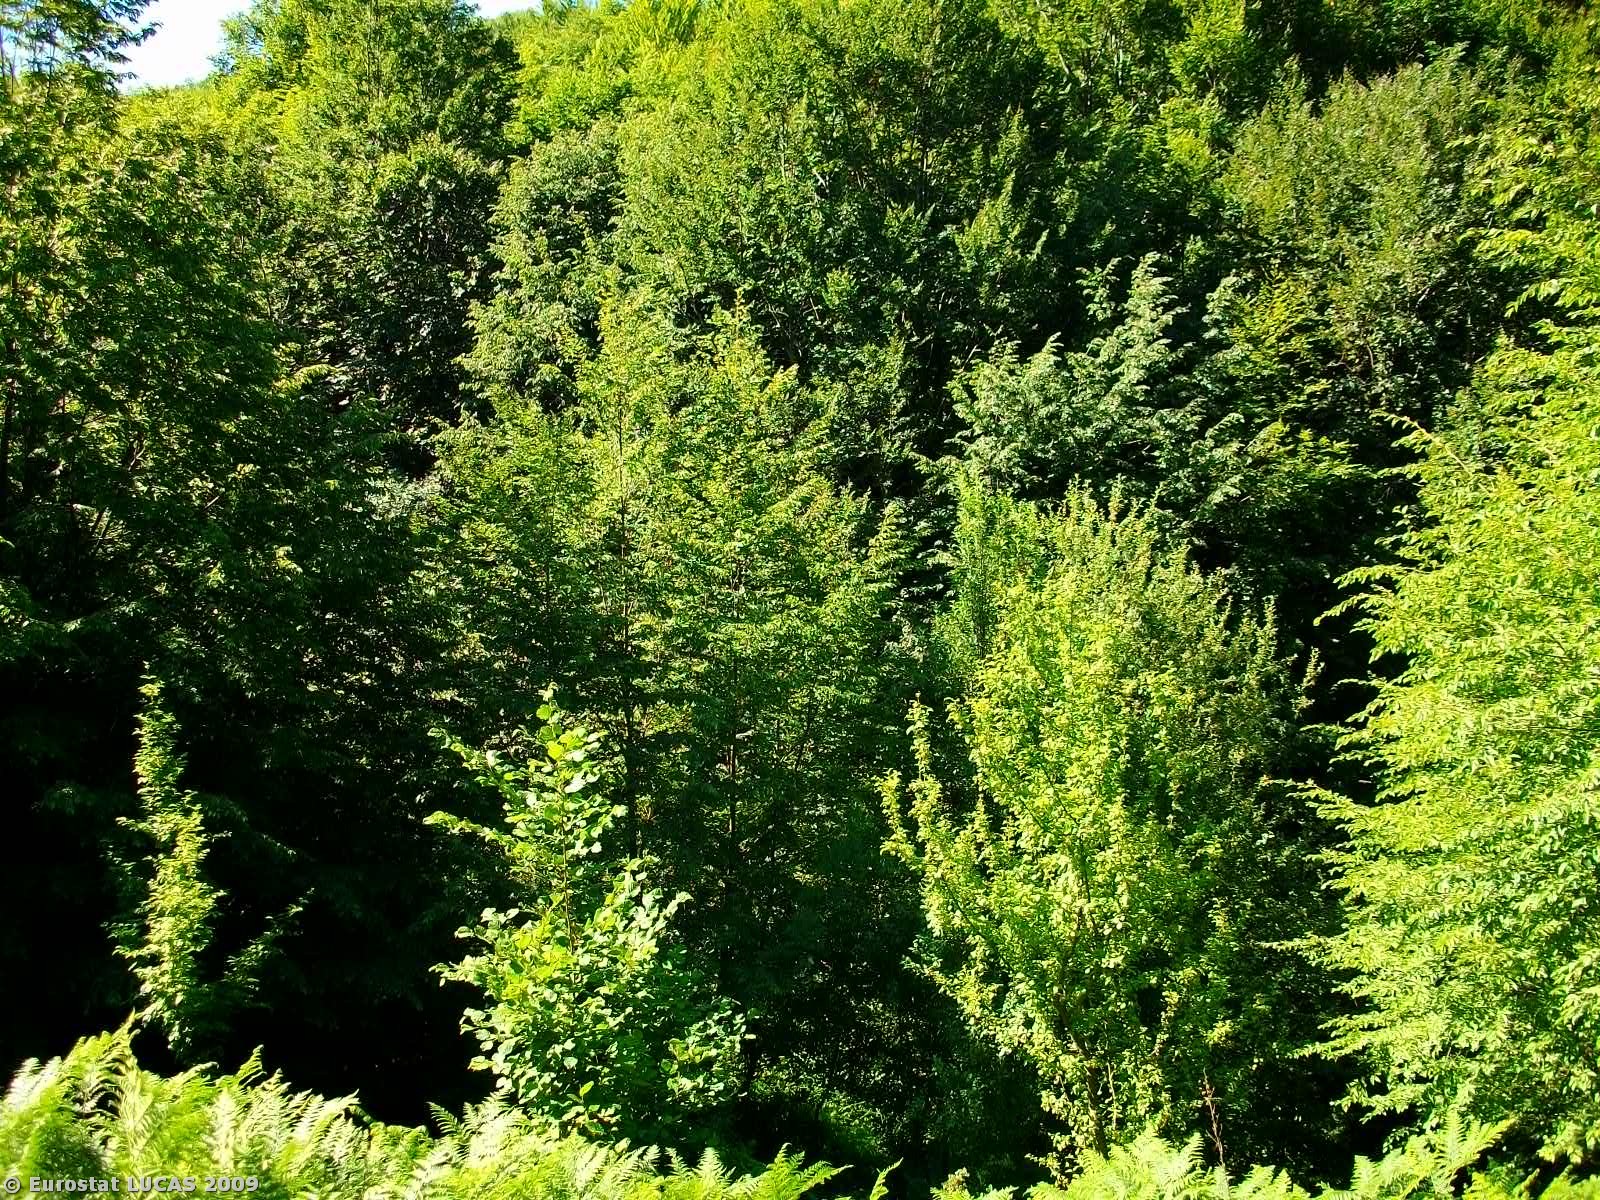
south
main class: Shrubland
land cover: Shrubland with sparse tree cover
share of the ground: > 75 %
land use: Agriculture (excluding fallow land and kitchen gardens)
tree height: > 5 m
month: June
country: GR
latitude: 41.2734
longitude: 25.5875
